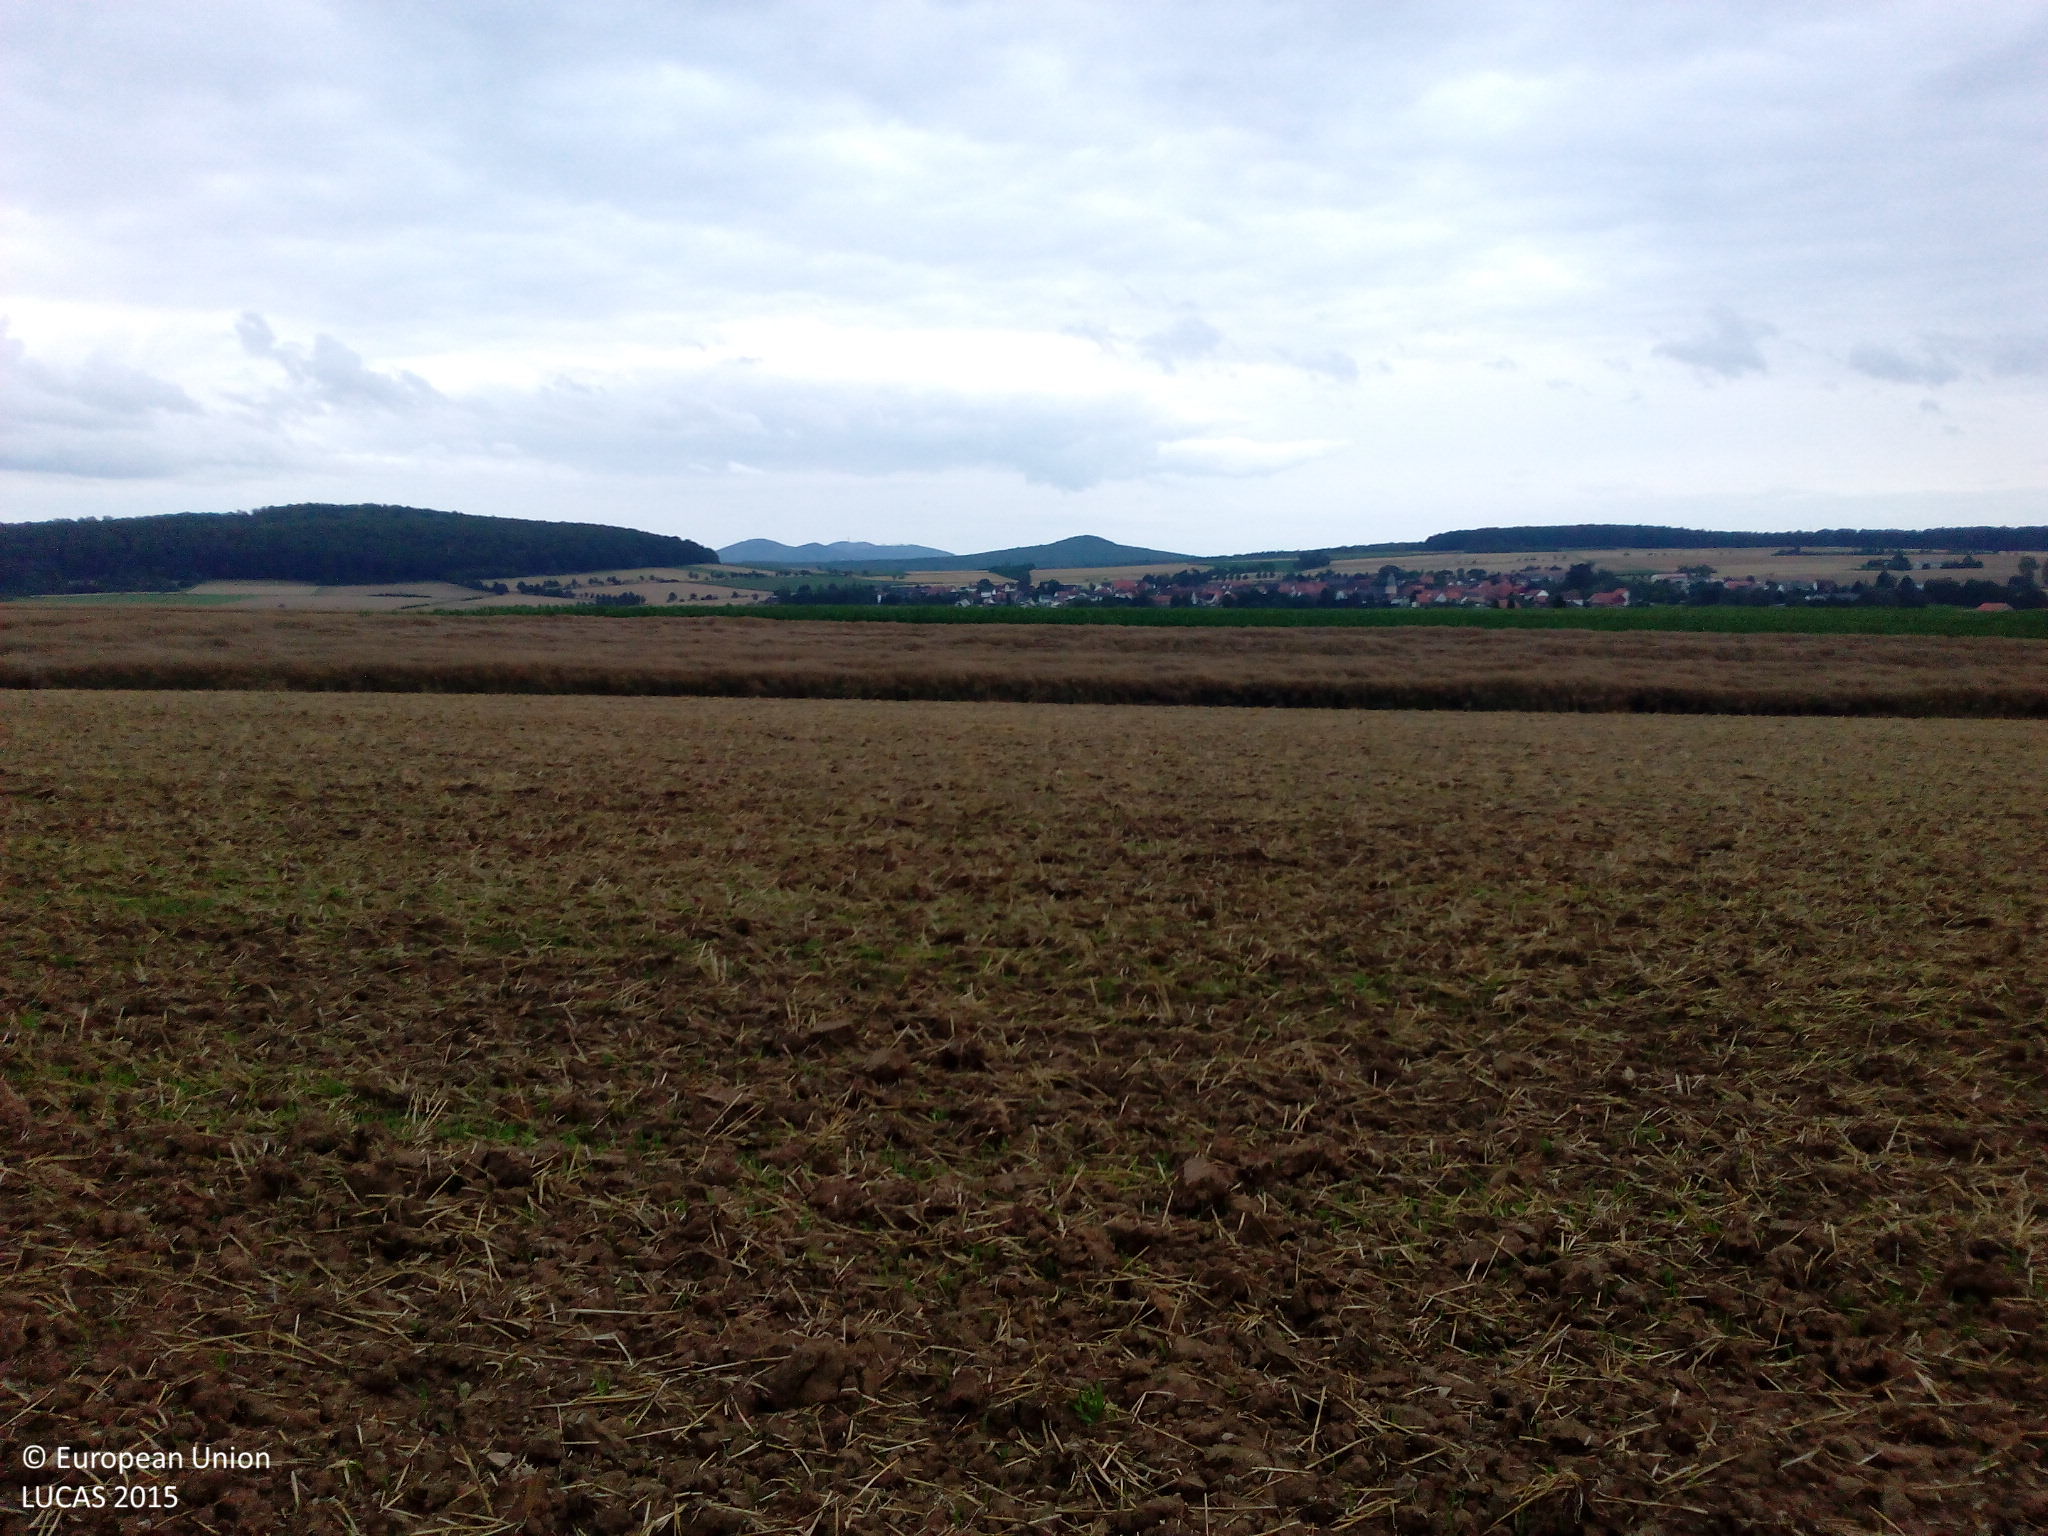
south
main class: Cropland
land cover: Rye
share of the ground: < 10 %
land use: Agriculture (excluding fallow land and kitchen gardens)
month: July
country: DE
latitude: 51.4582
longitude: 9.2374
